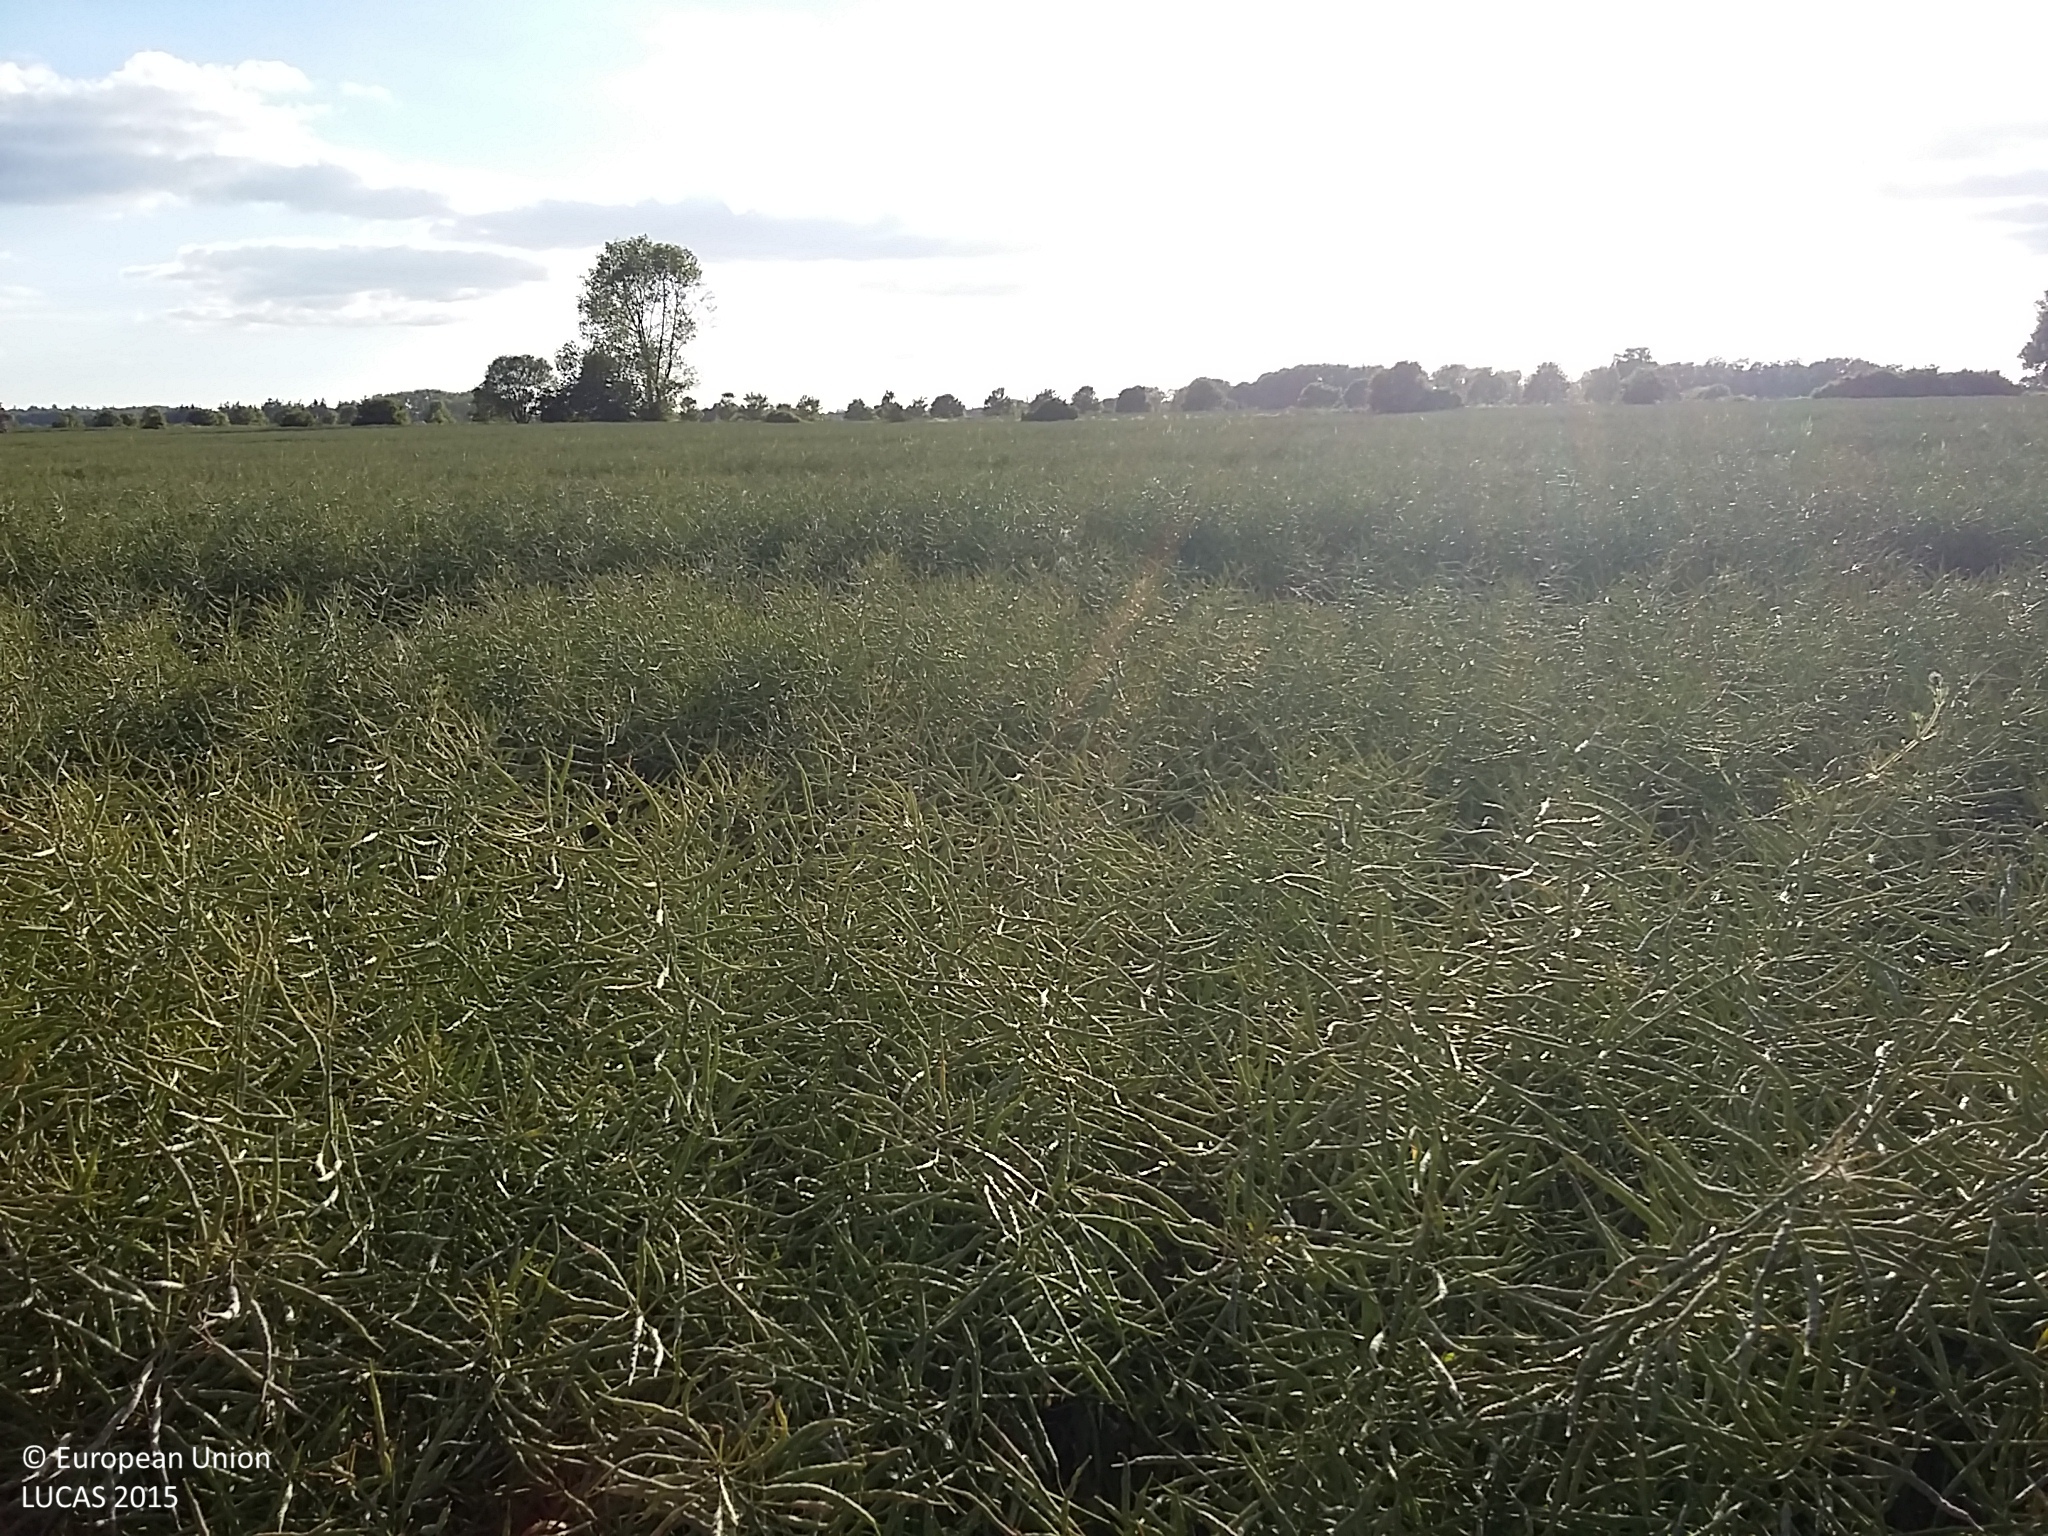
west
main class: Cropland
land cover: Rape and turnip rape
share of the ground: > 75 %
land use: Agriculture (excluding fallow land and kitchen gardens)
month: June
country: DK
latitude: 55.2150
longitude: 10.7381
